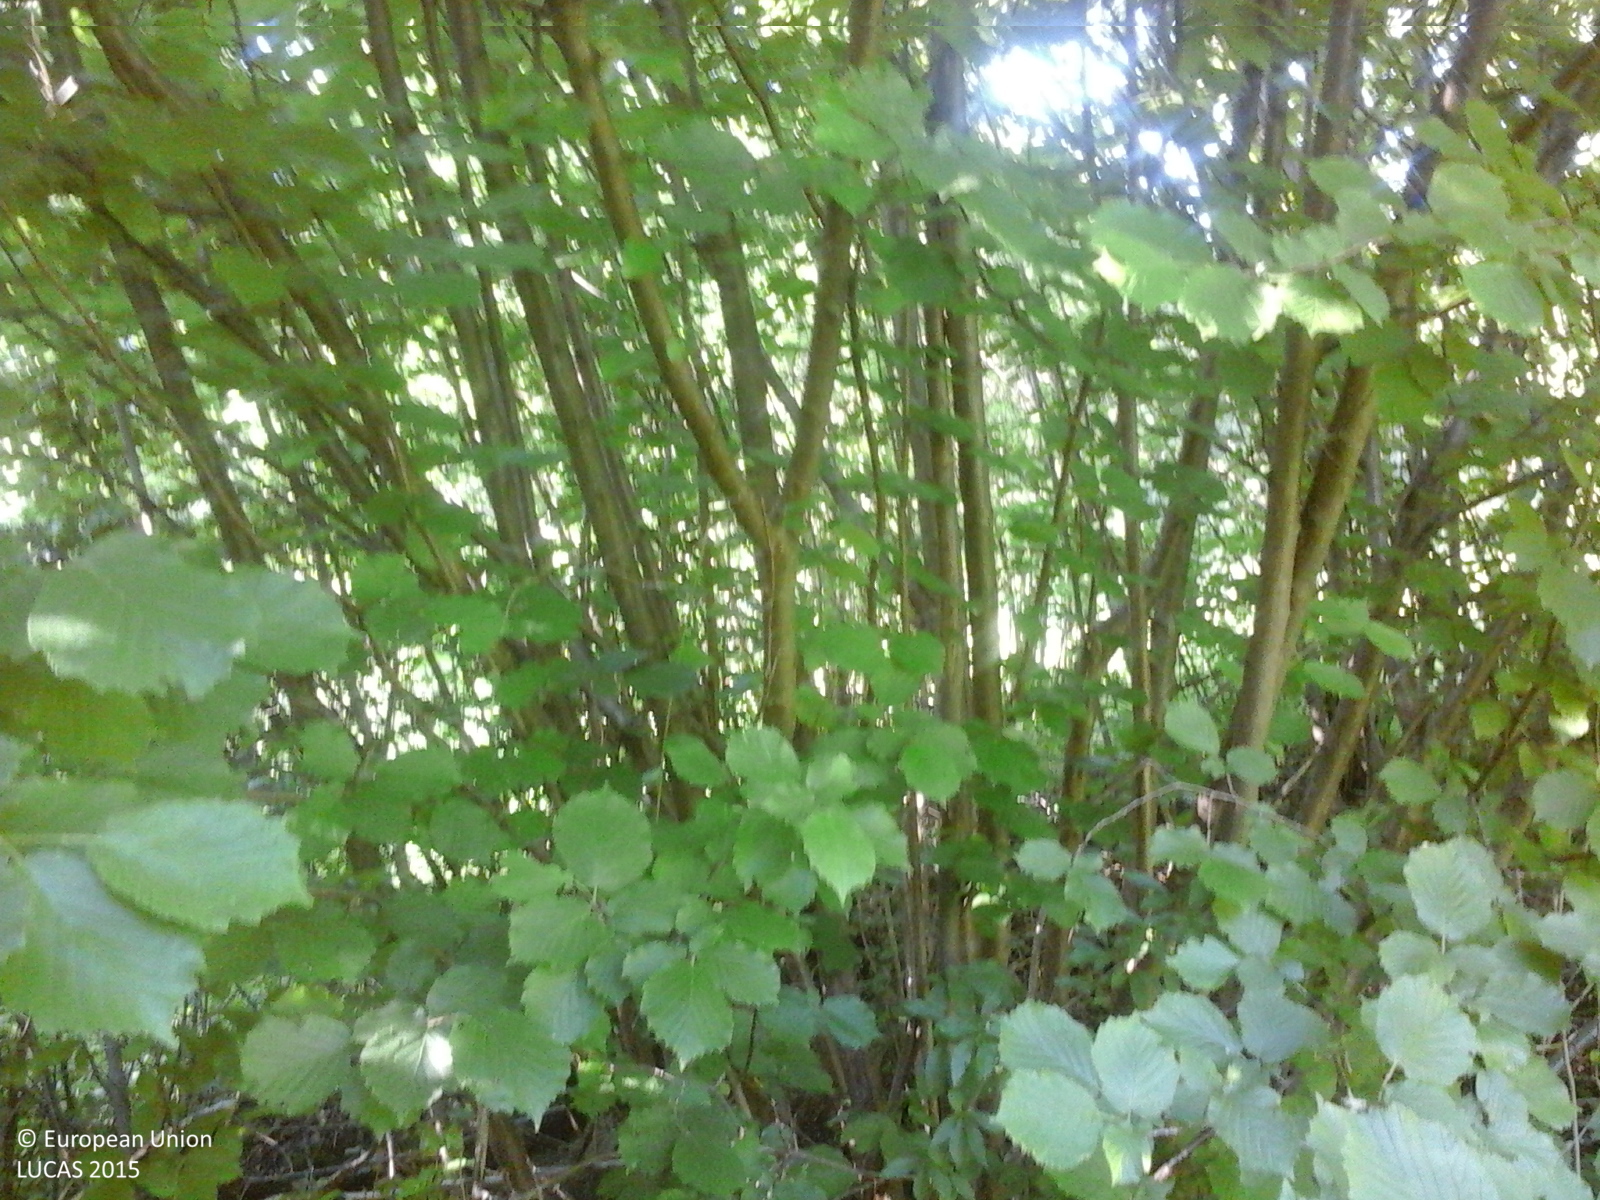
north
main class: Woodland
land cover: Broadleaved woodland
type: non-riverine alder, birch or aspen forest
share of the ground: > 75 %
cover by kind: broadleaved forest trees 100 %
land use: Forestry
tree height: > 5 m
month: June
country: RO
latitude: 45.0884
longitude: 25.7172
